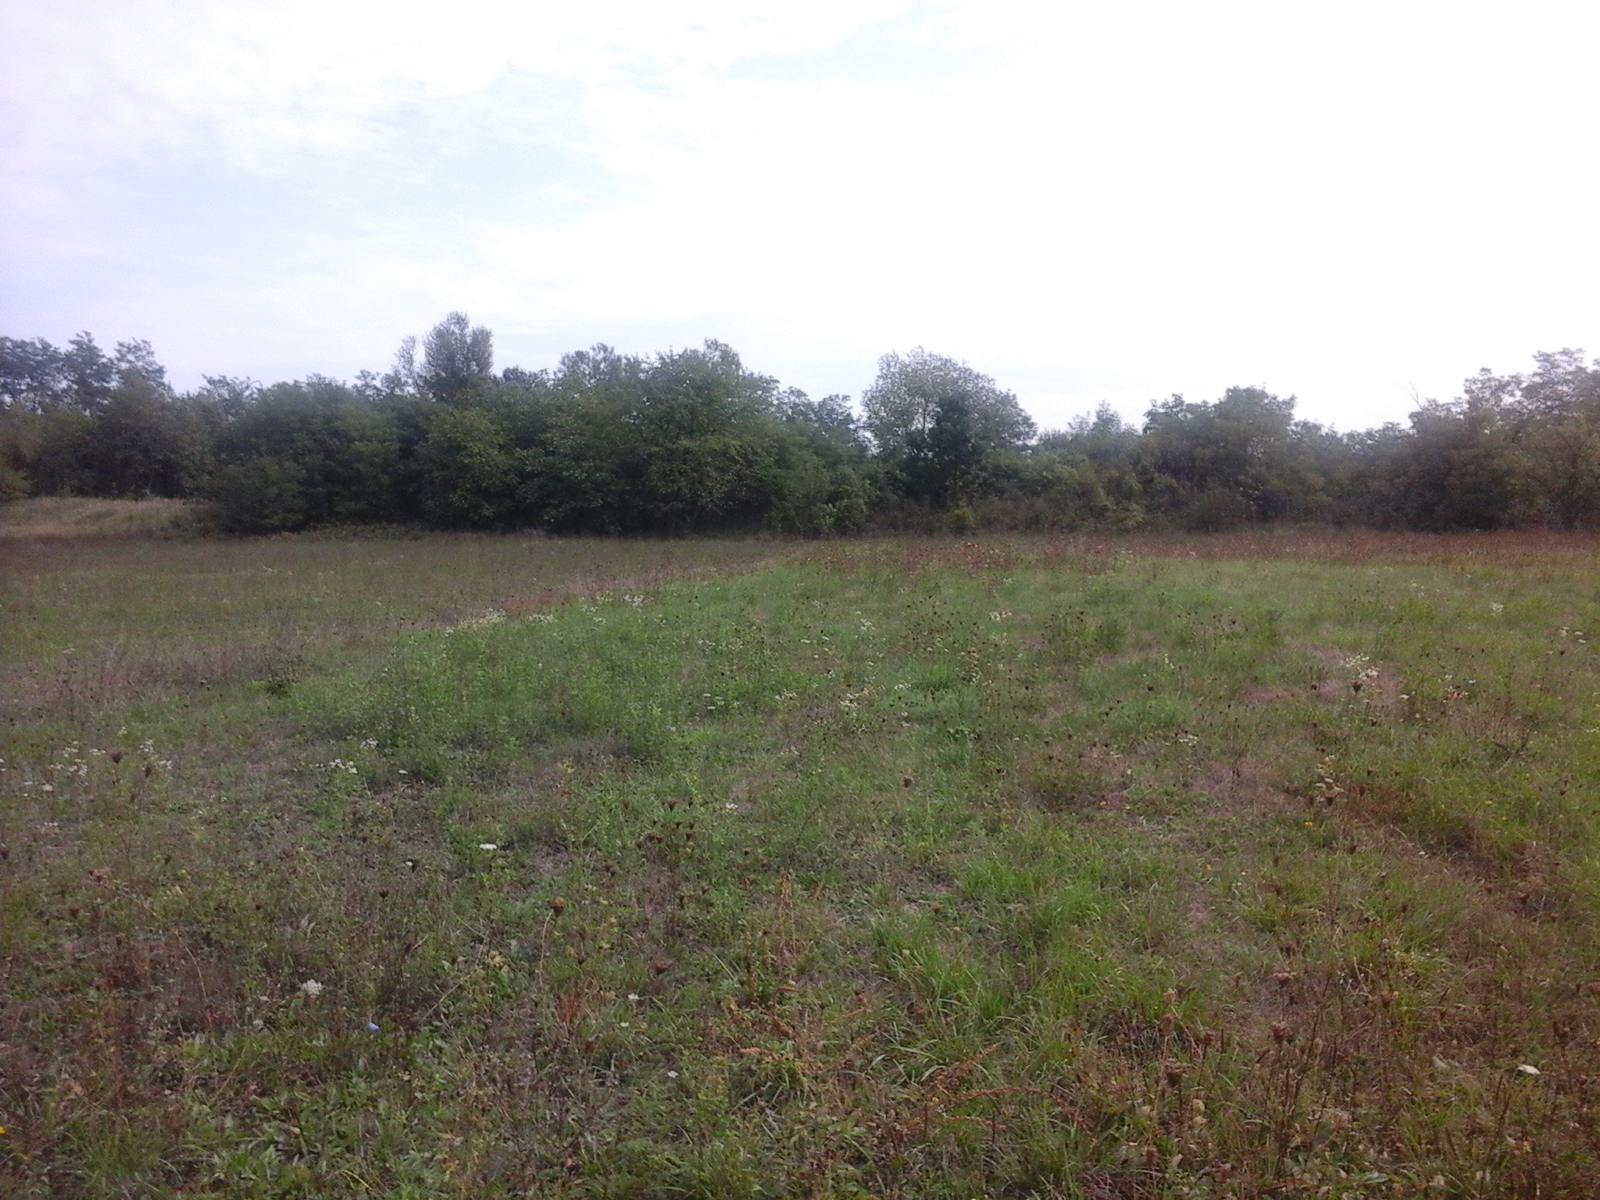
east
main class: Grassland
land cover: Spontaneously vegetated surfaces
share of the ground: > 75 %
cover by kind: herbaceous plants 100 %
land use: Agriculture (excluding fallow land and kitchen gardens)
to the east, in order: Spontaneously vegetated surfaces; Broadleaved woodland; Arable land (only in case pi)
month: September
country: RO
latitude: 45.7159
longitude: 23.0170
